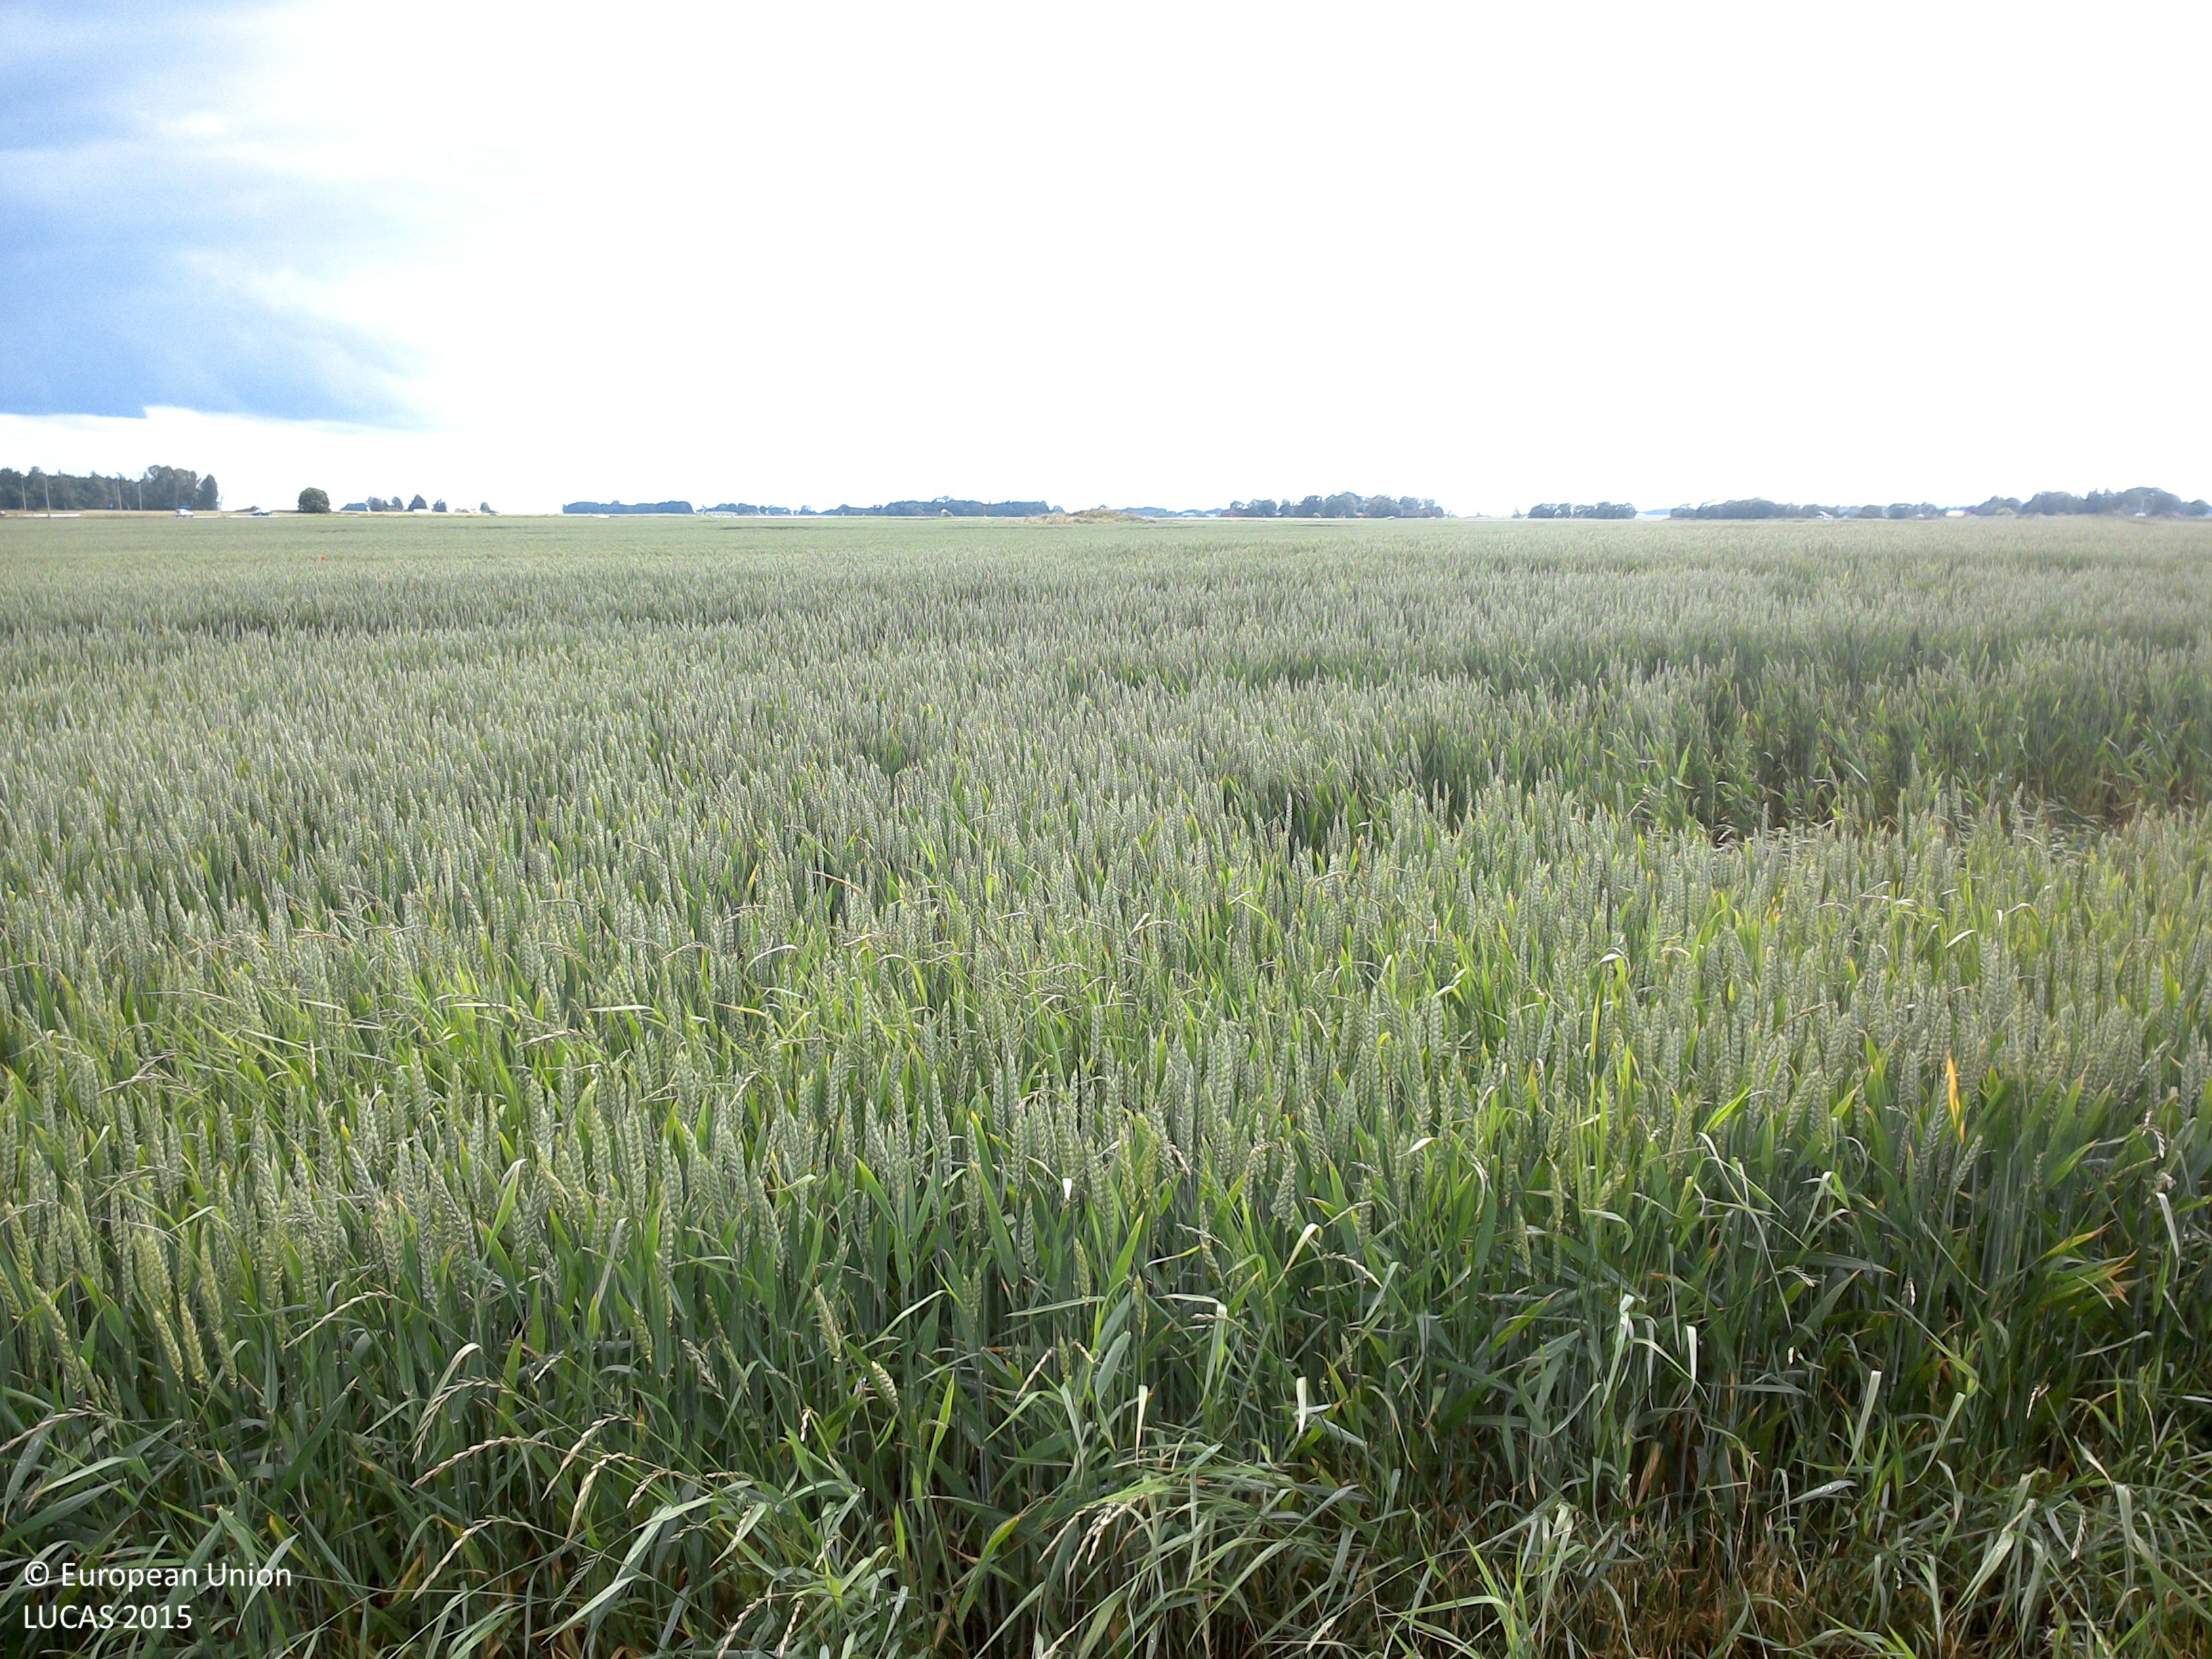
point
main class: Cropland
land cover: Common wheat
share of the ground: > 75 %
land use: Agriculture (excluding fallow land and kitchen gardens)
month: July
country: SE
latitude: 58.4375
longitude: 14.8755
